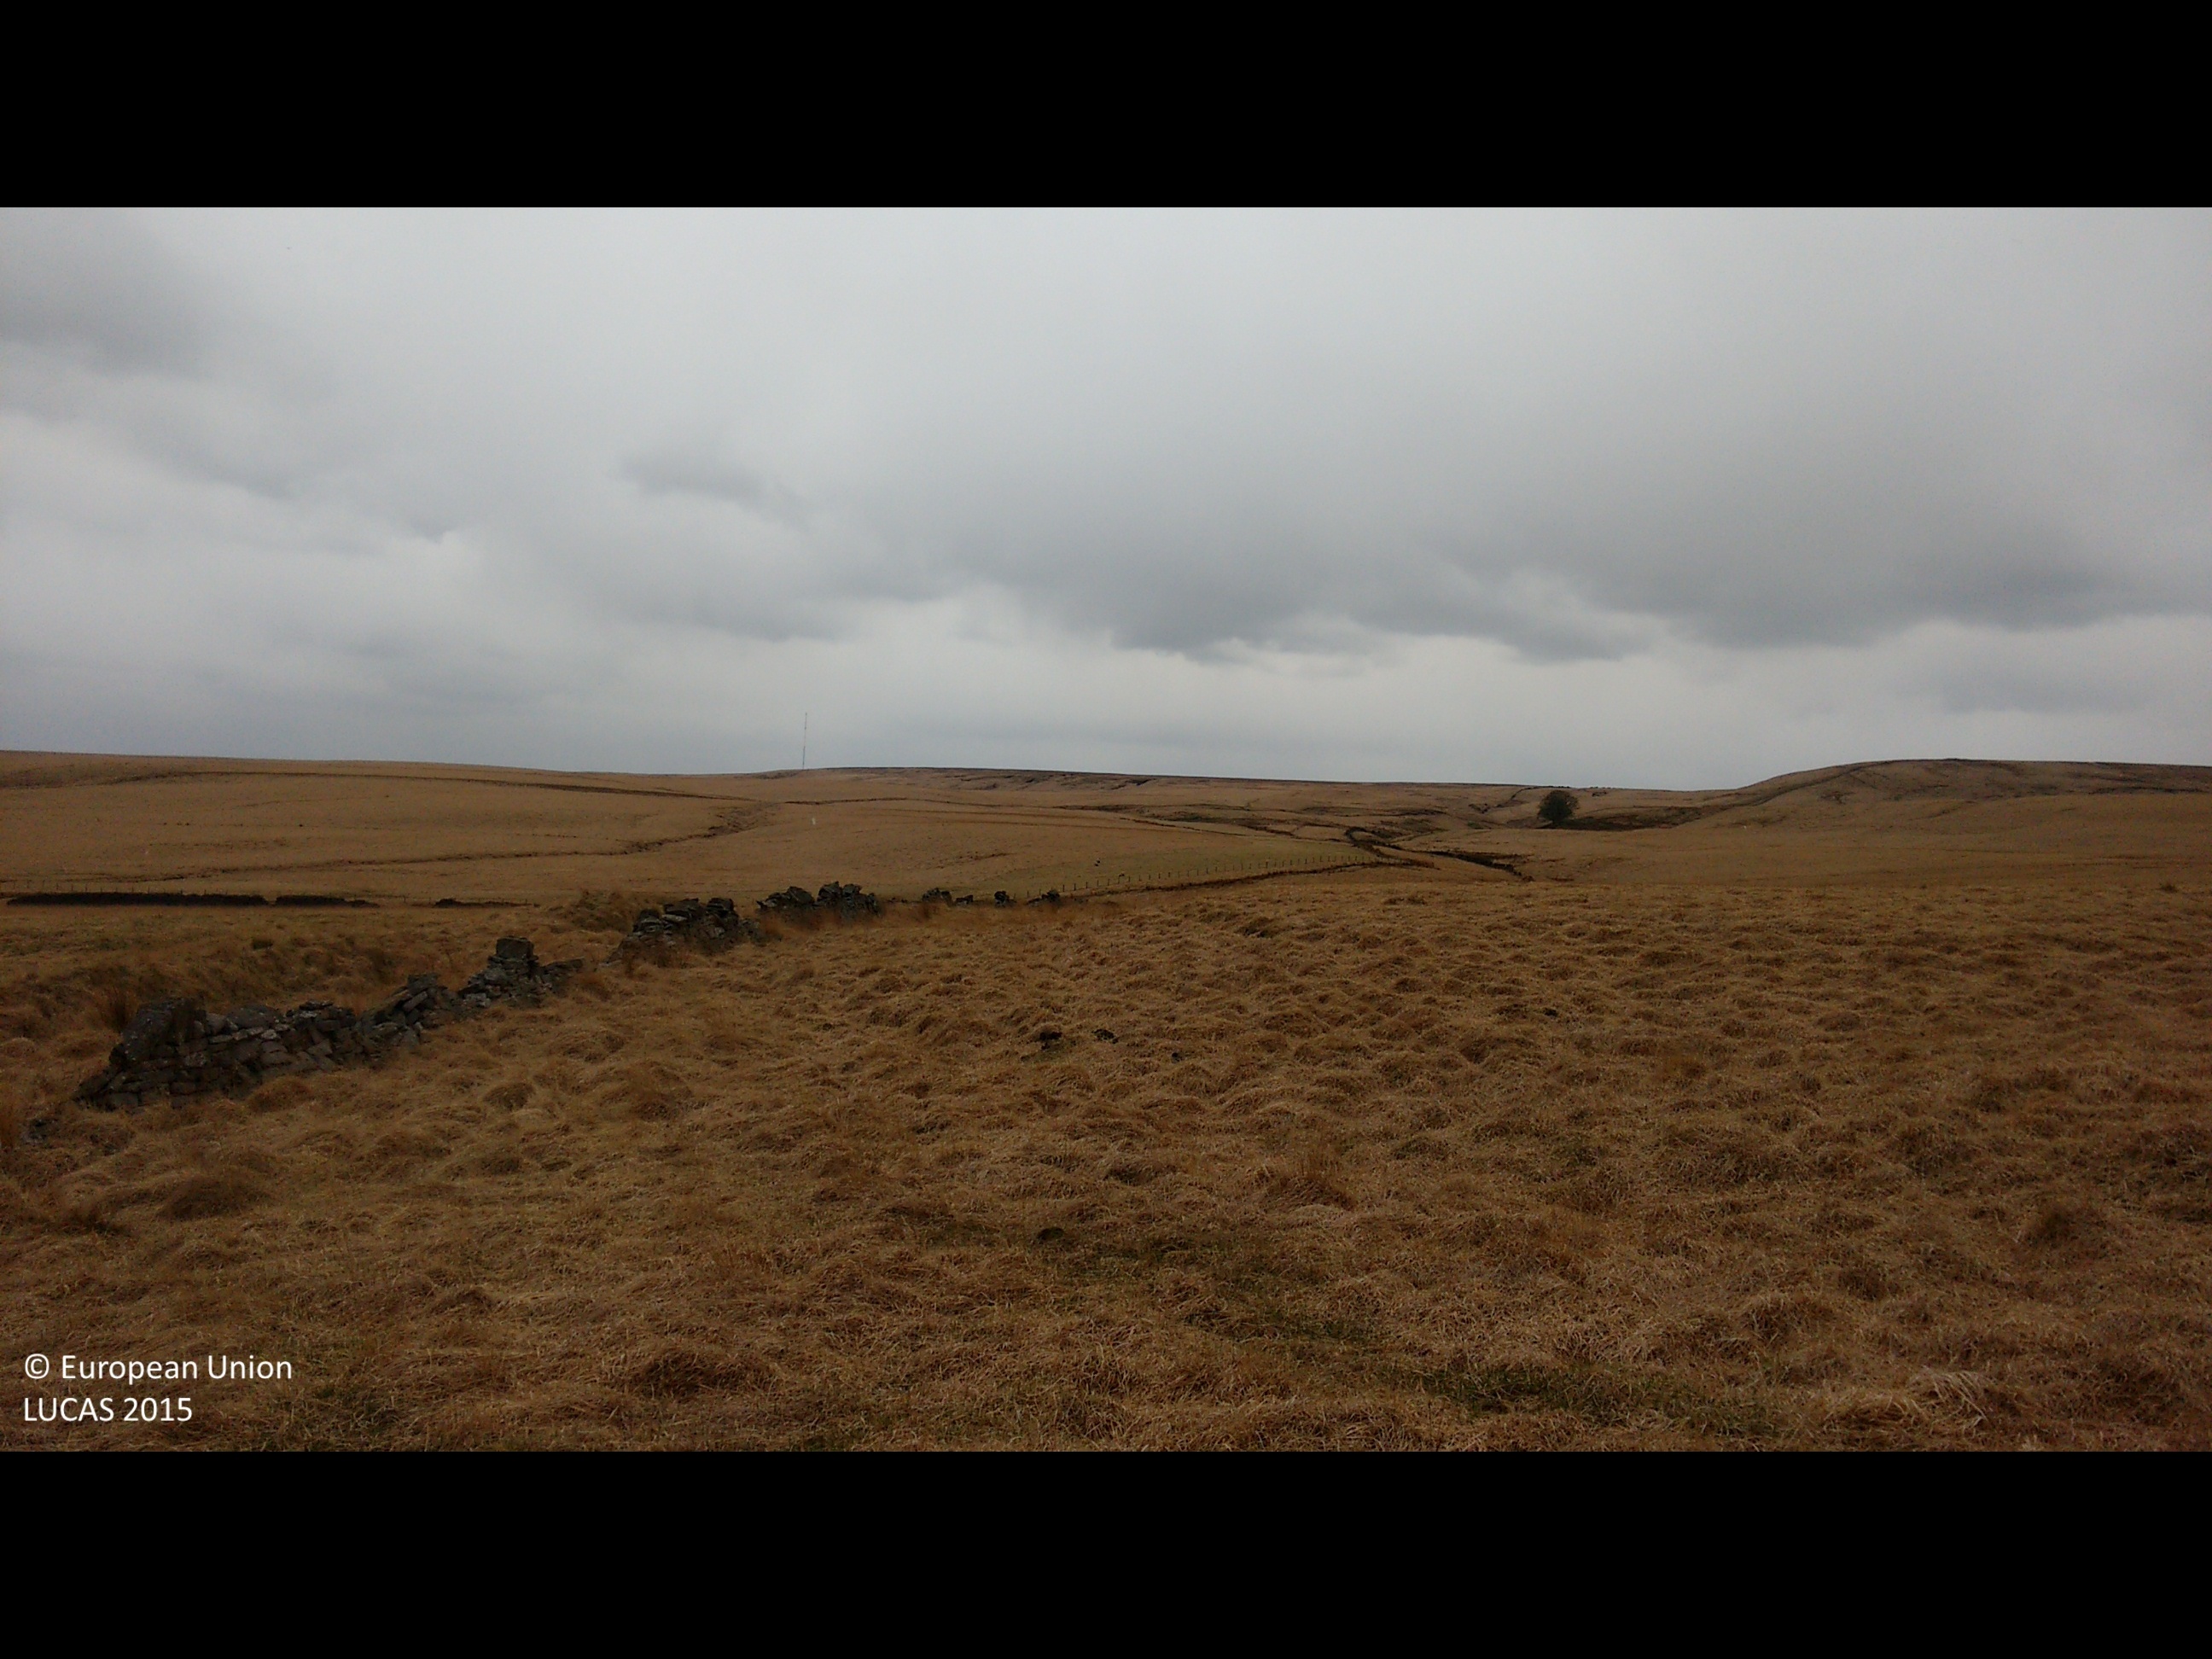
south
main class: Grassland
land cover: Grassland without tree/shrub cover
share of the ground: > 75 %
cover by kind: herbaceous plants 100 %
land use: Agriculture (excluding fallow land and kitchen gardens)
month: May
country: GB
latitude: 53.6769
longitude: -2.5247
